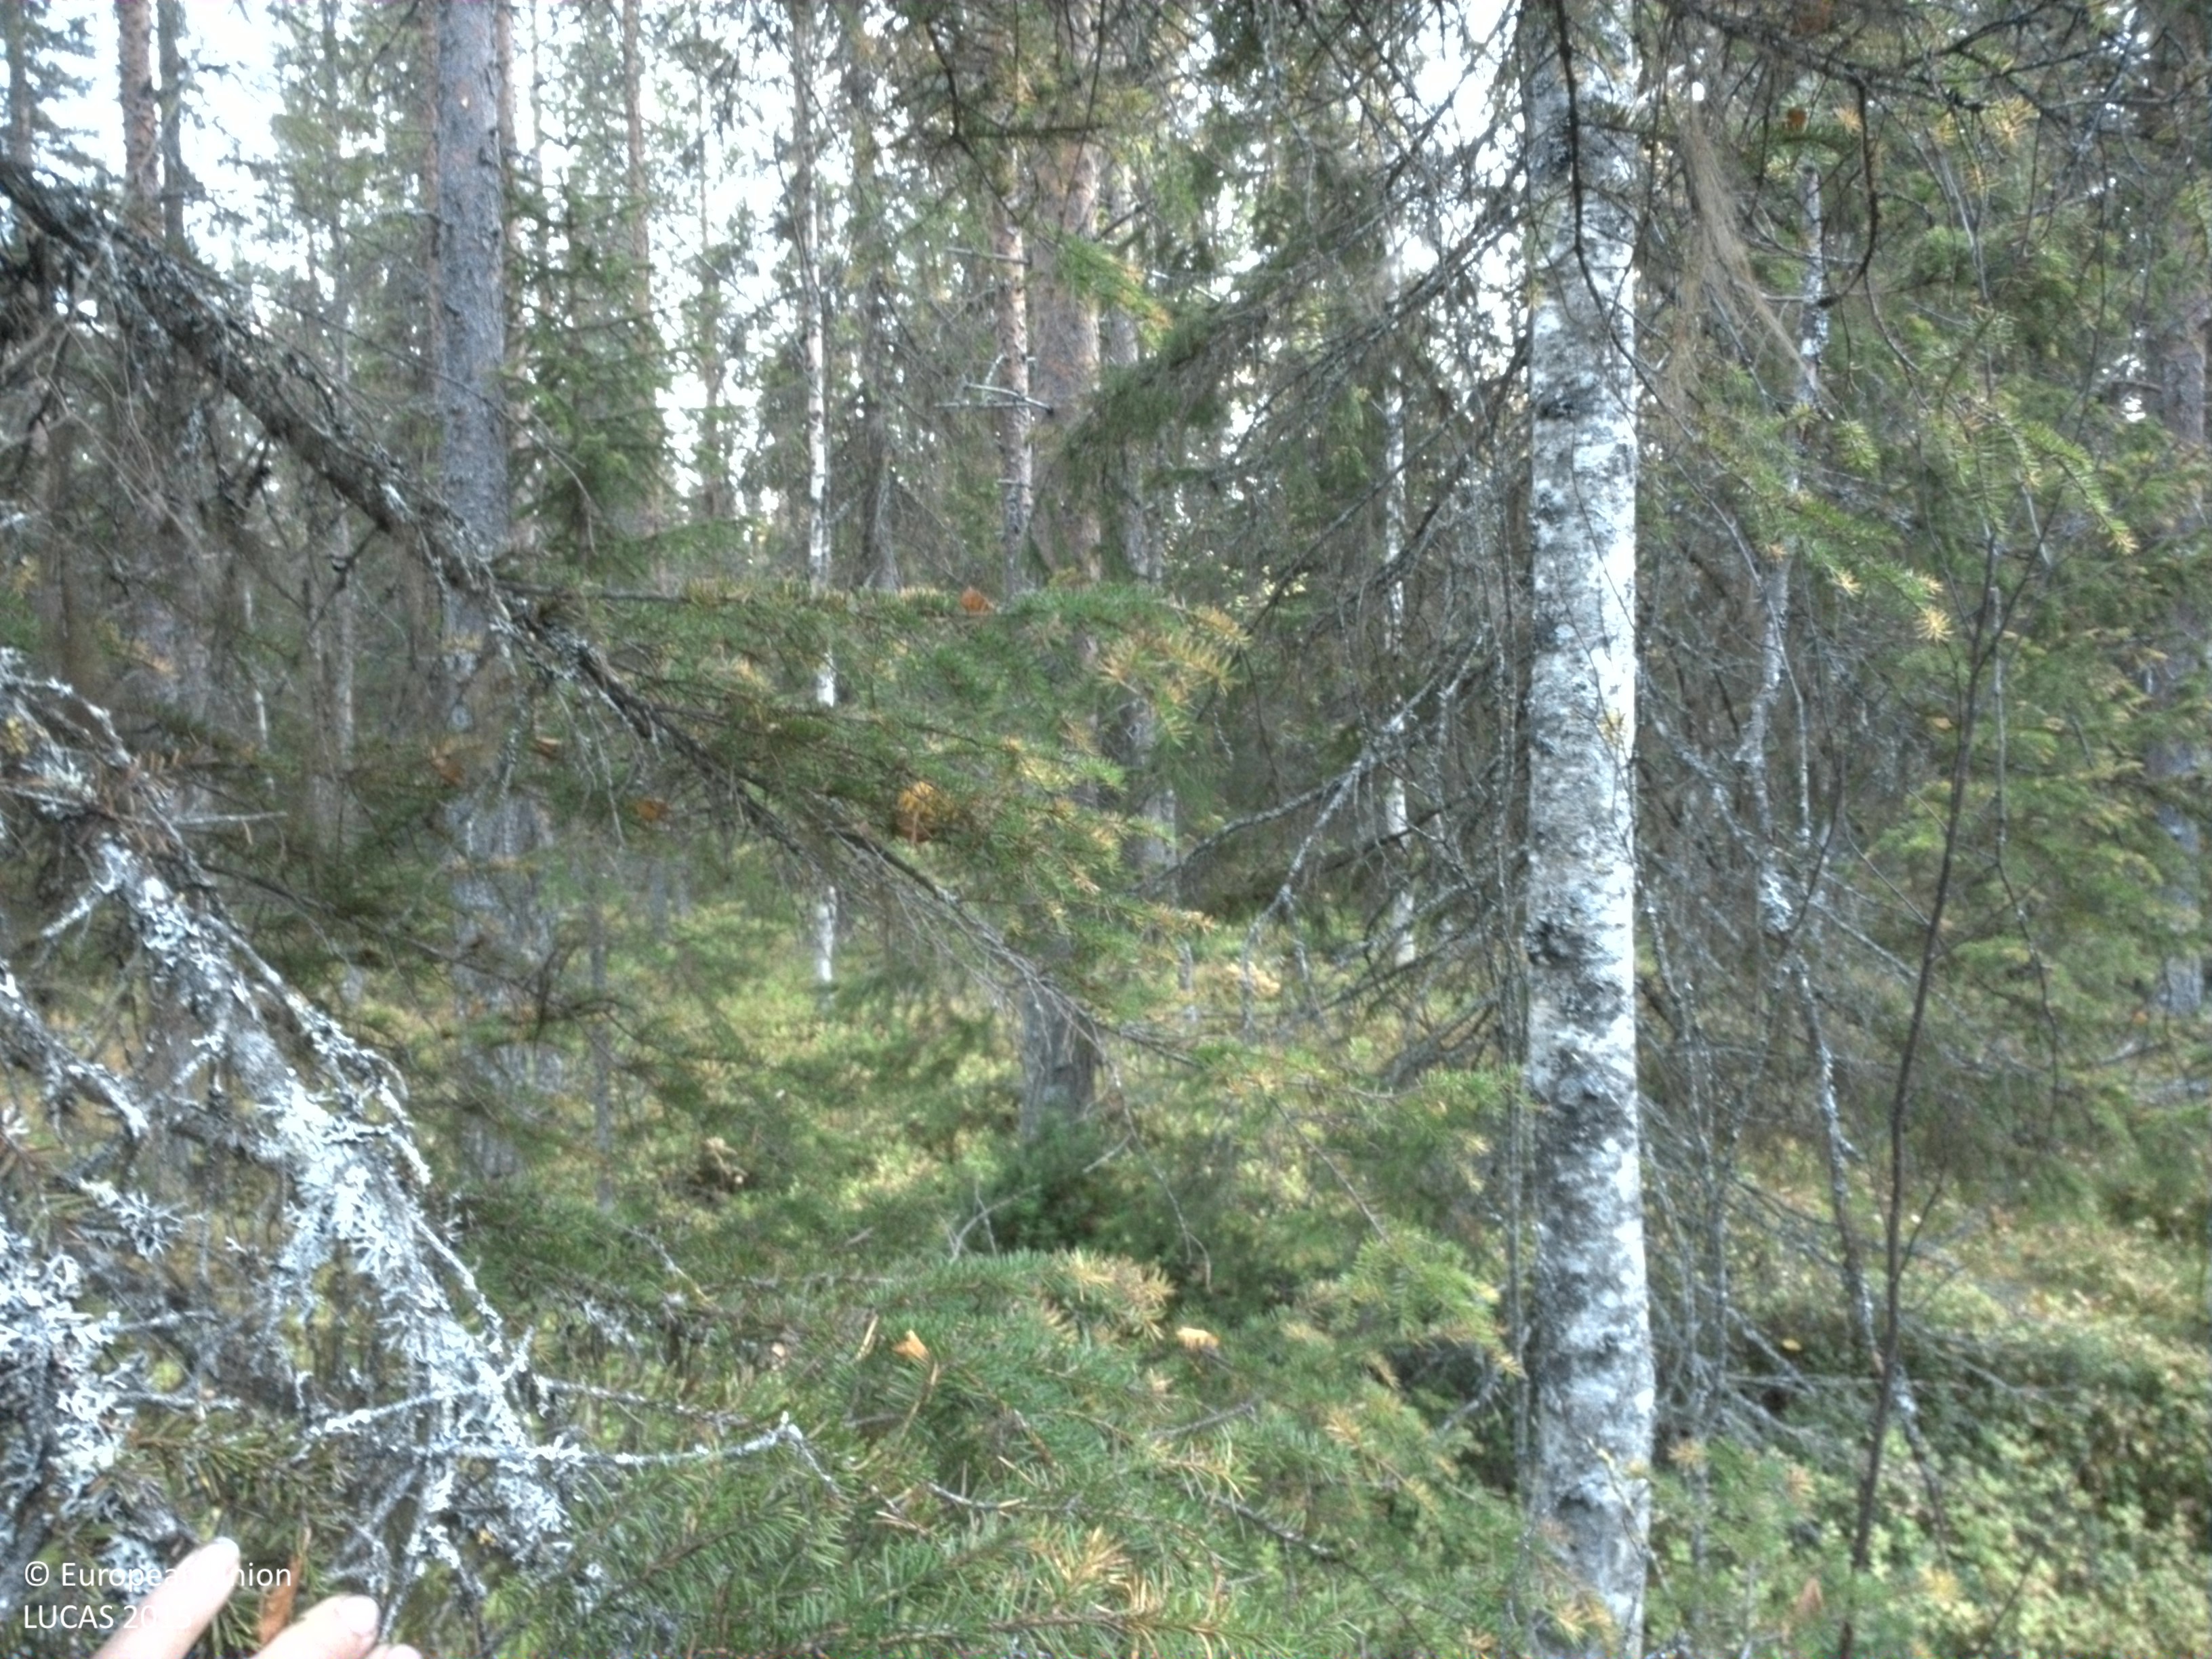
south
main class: Woodland
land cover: Other mixed woodland
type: boreal forest
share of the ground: 25 - 50 %
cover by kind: shrubs 40 %, broadleaved forest trees 25 %, lichens and mosses 20 %, coniferous forest trees 10 %, herbaceous plants 5 %
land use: Forestry
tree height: > 5 m
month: September
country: SE
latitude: 64.9999
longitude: 17.5343
